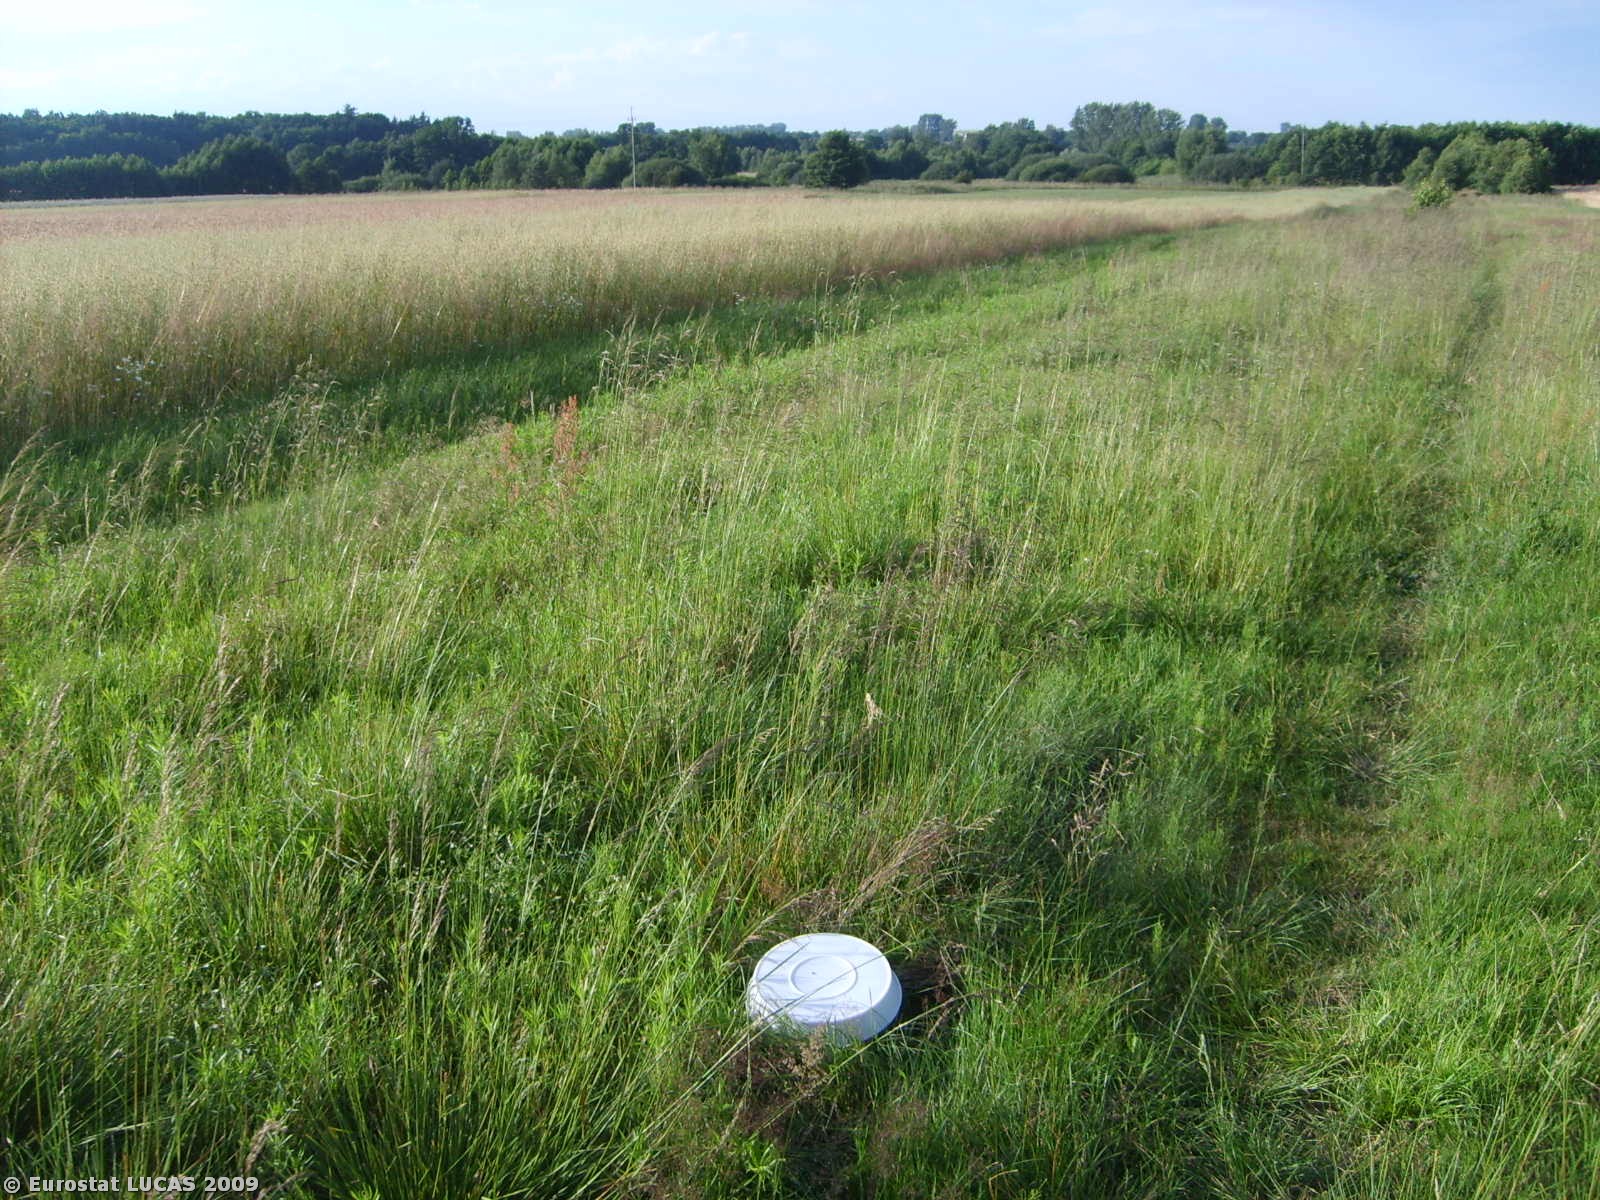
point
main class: Grassland
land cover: Grassland without tree/shrub cover
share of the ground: > 75 %
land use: Agriculture (excluding fallow land and kitchen gardens)
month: July
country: PL
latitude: 50.2688
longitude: 20.6034
